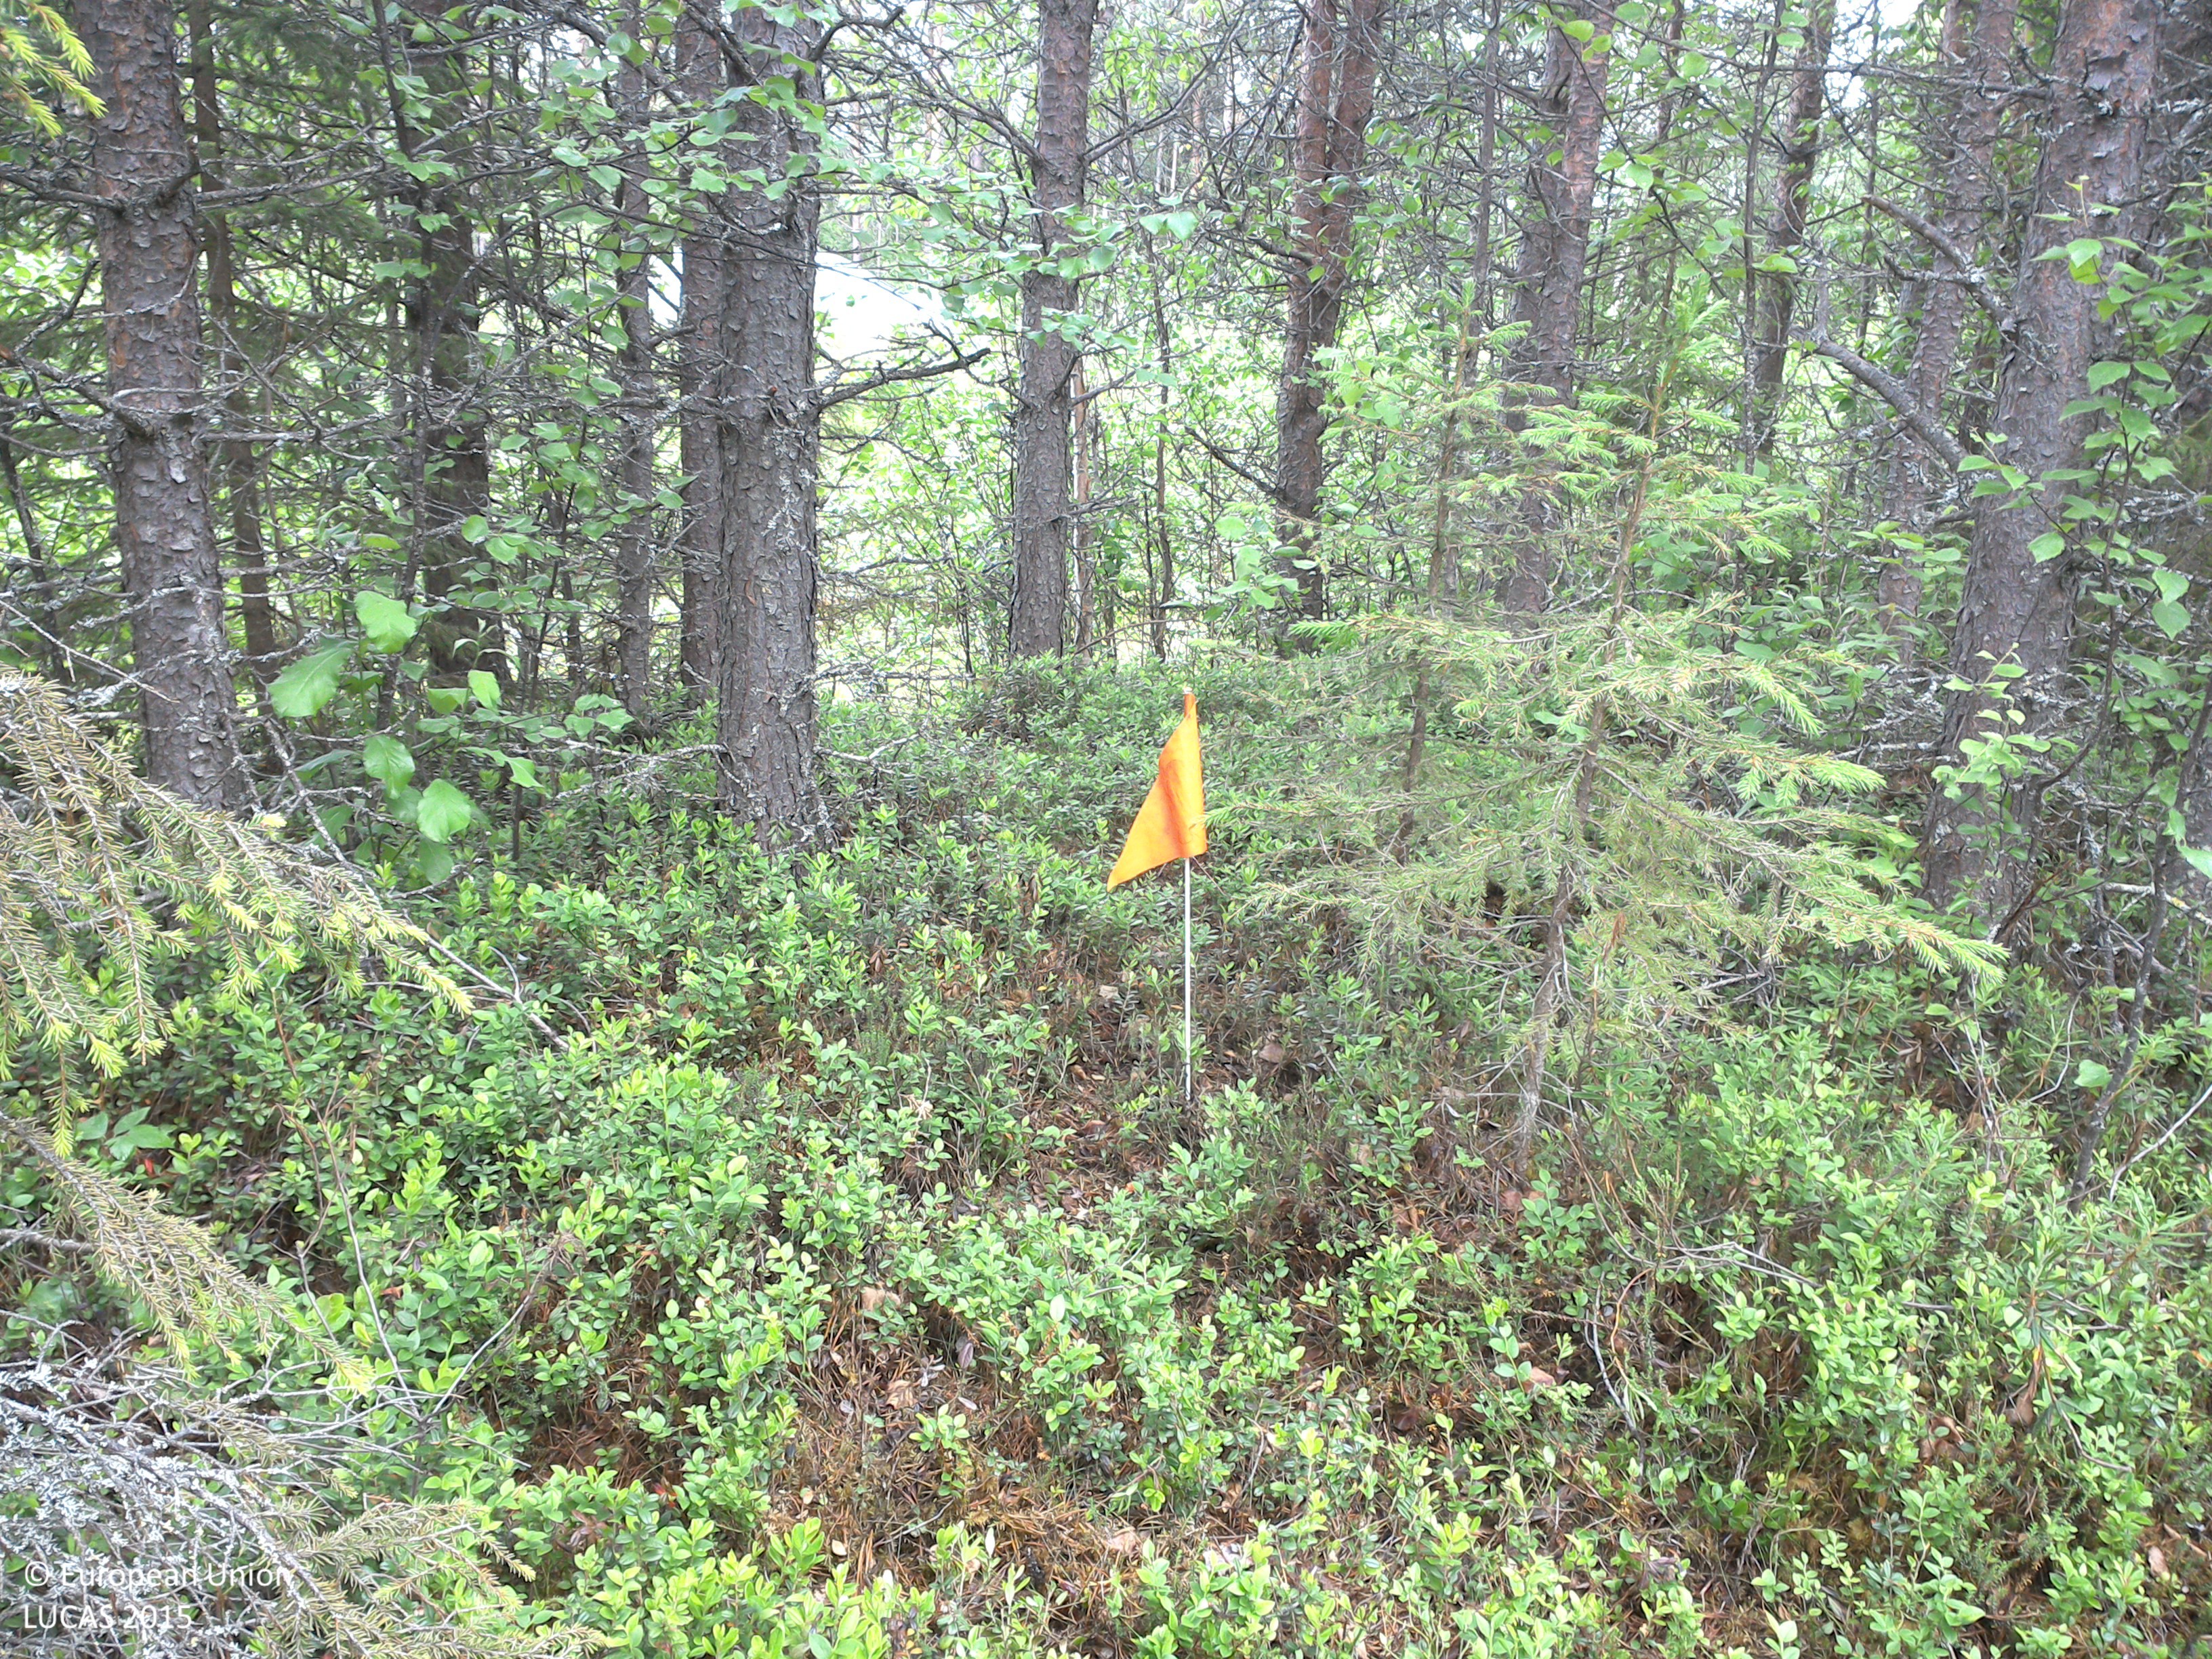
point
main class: Woodland
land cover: Pine dominated mixed woodland
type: boreal forest
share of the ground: 25 - 50 %
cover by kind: shrubs 60 %, coniferous forest trees 25 %, broadleaved forest trees 10 %, lichens and mosses 5 %
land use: Forestry
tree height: > 5 m
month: July
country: SE
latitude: 66.8554
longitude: 23.7300
